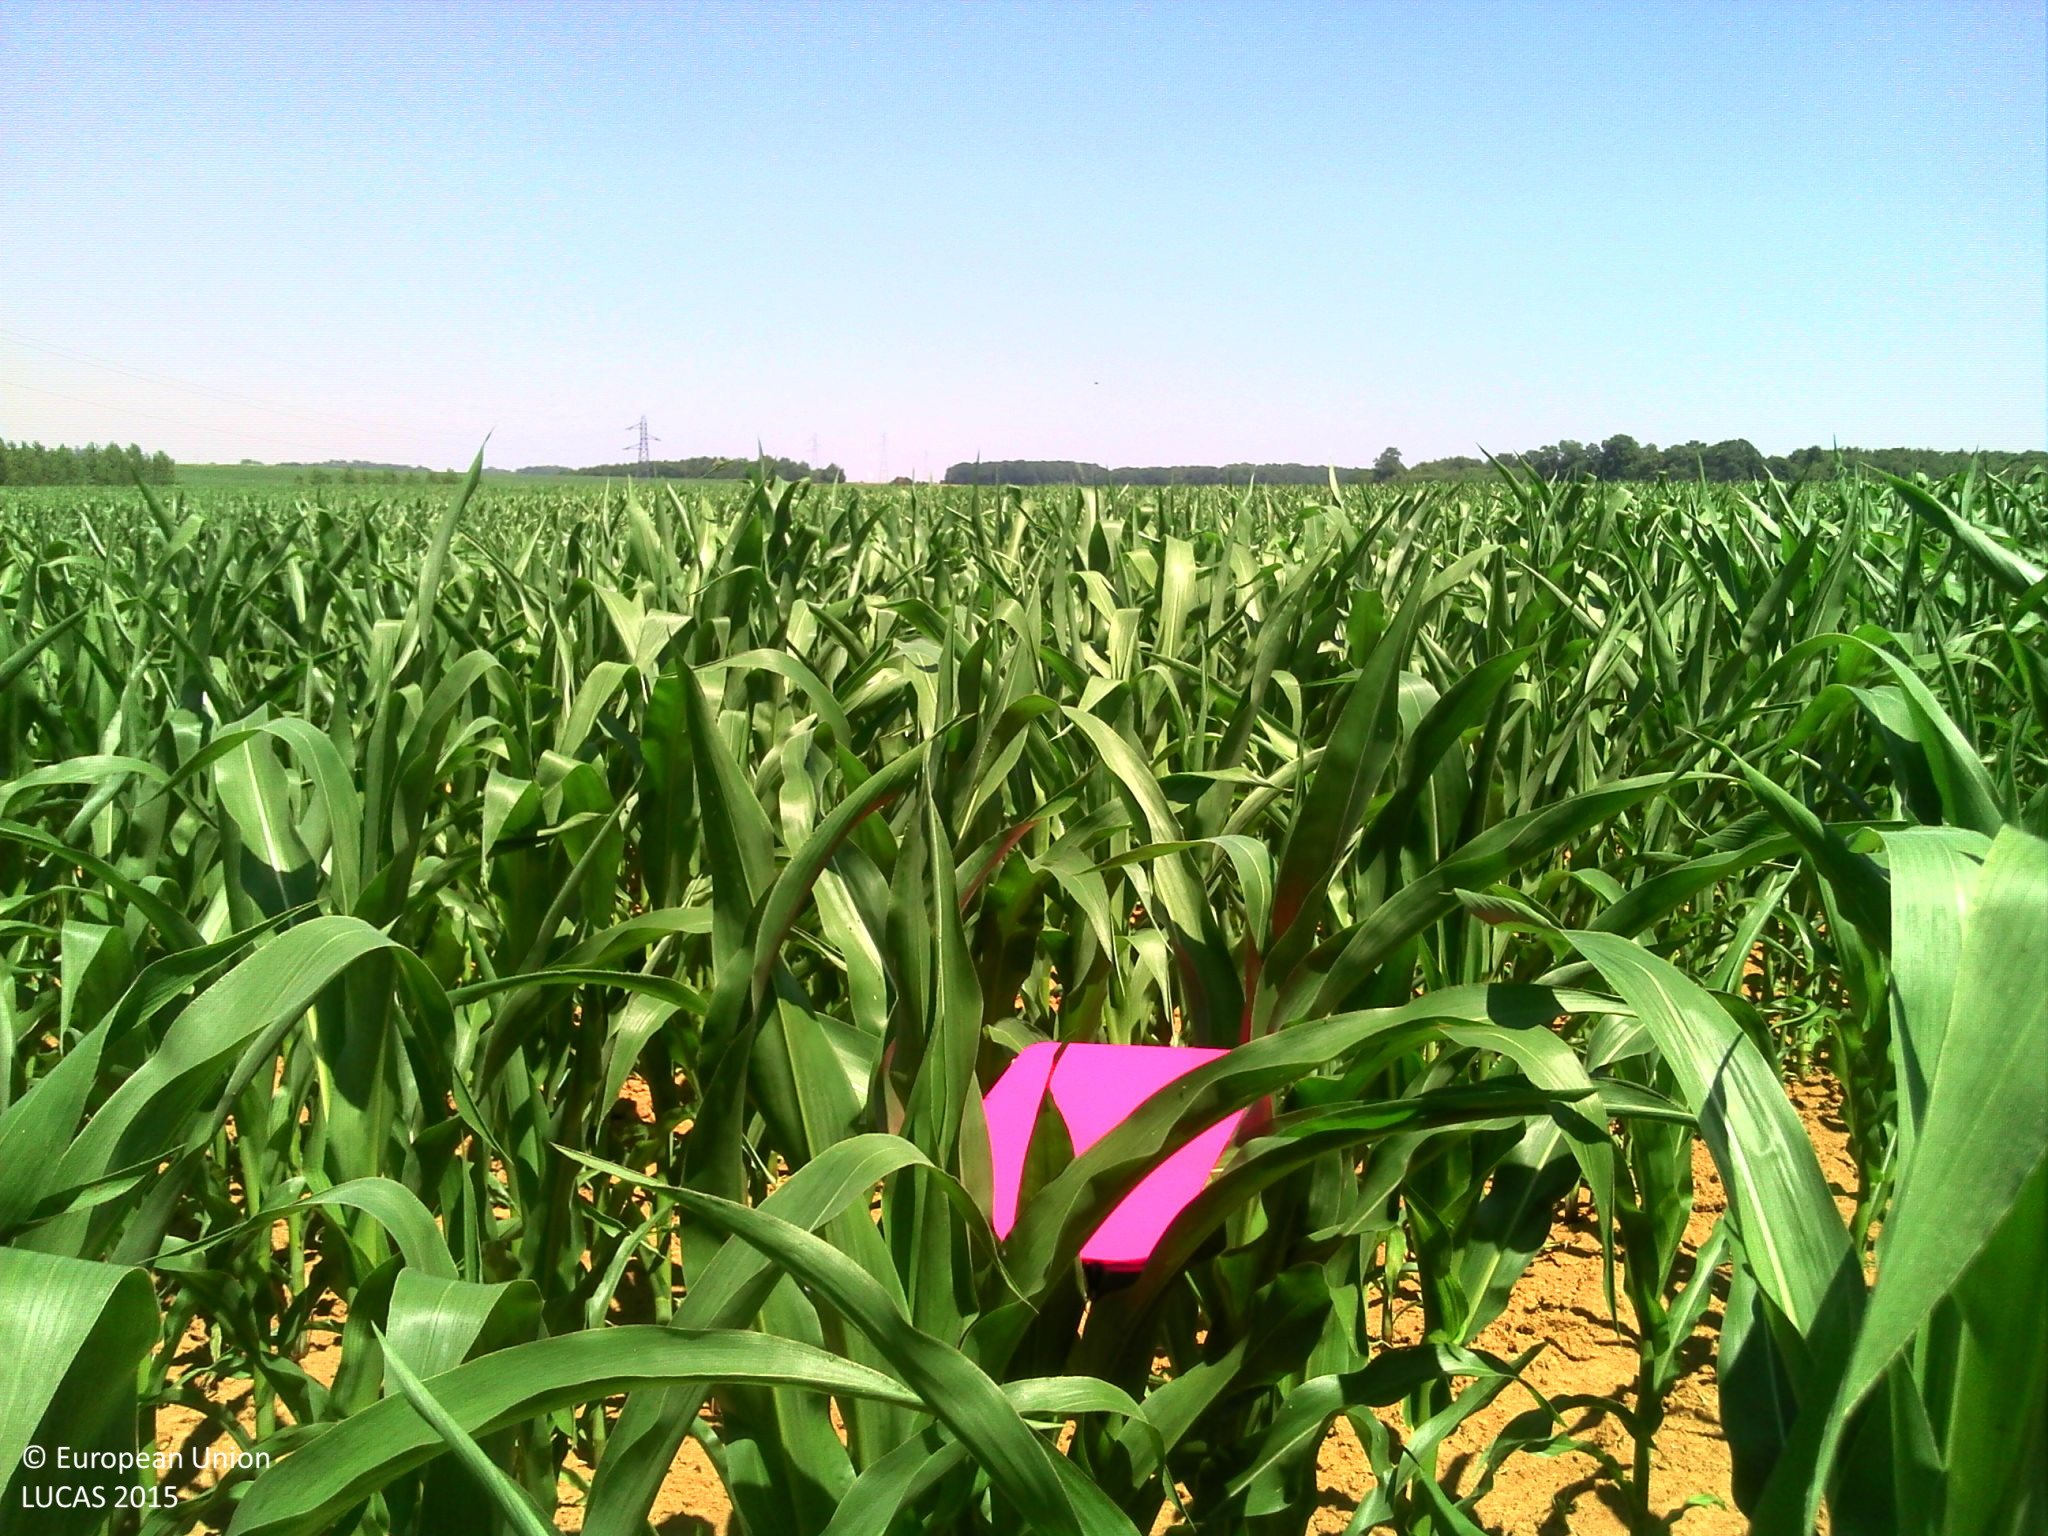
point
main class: Cropland
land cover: Maize
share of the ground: 50 - 75 %
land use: Agriculture (excluding fallow land and kitchen gardens)
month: July
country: FR
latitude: 48.8910
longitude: 5.1291
